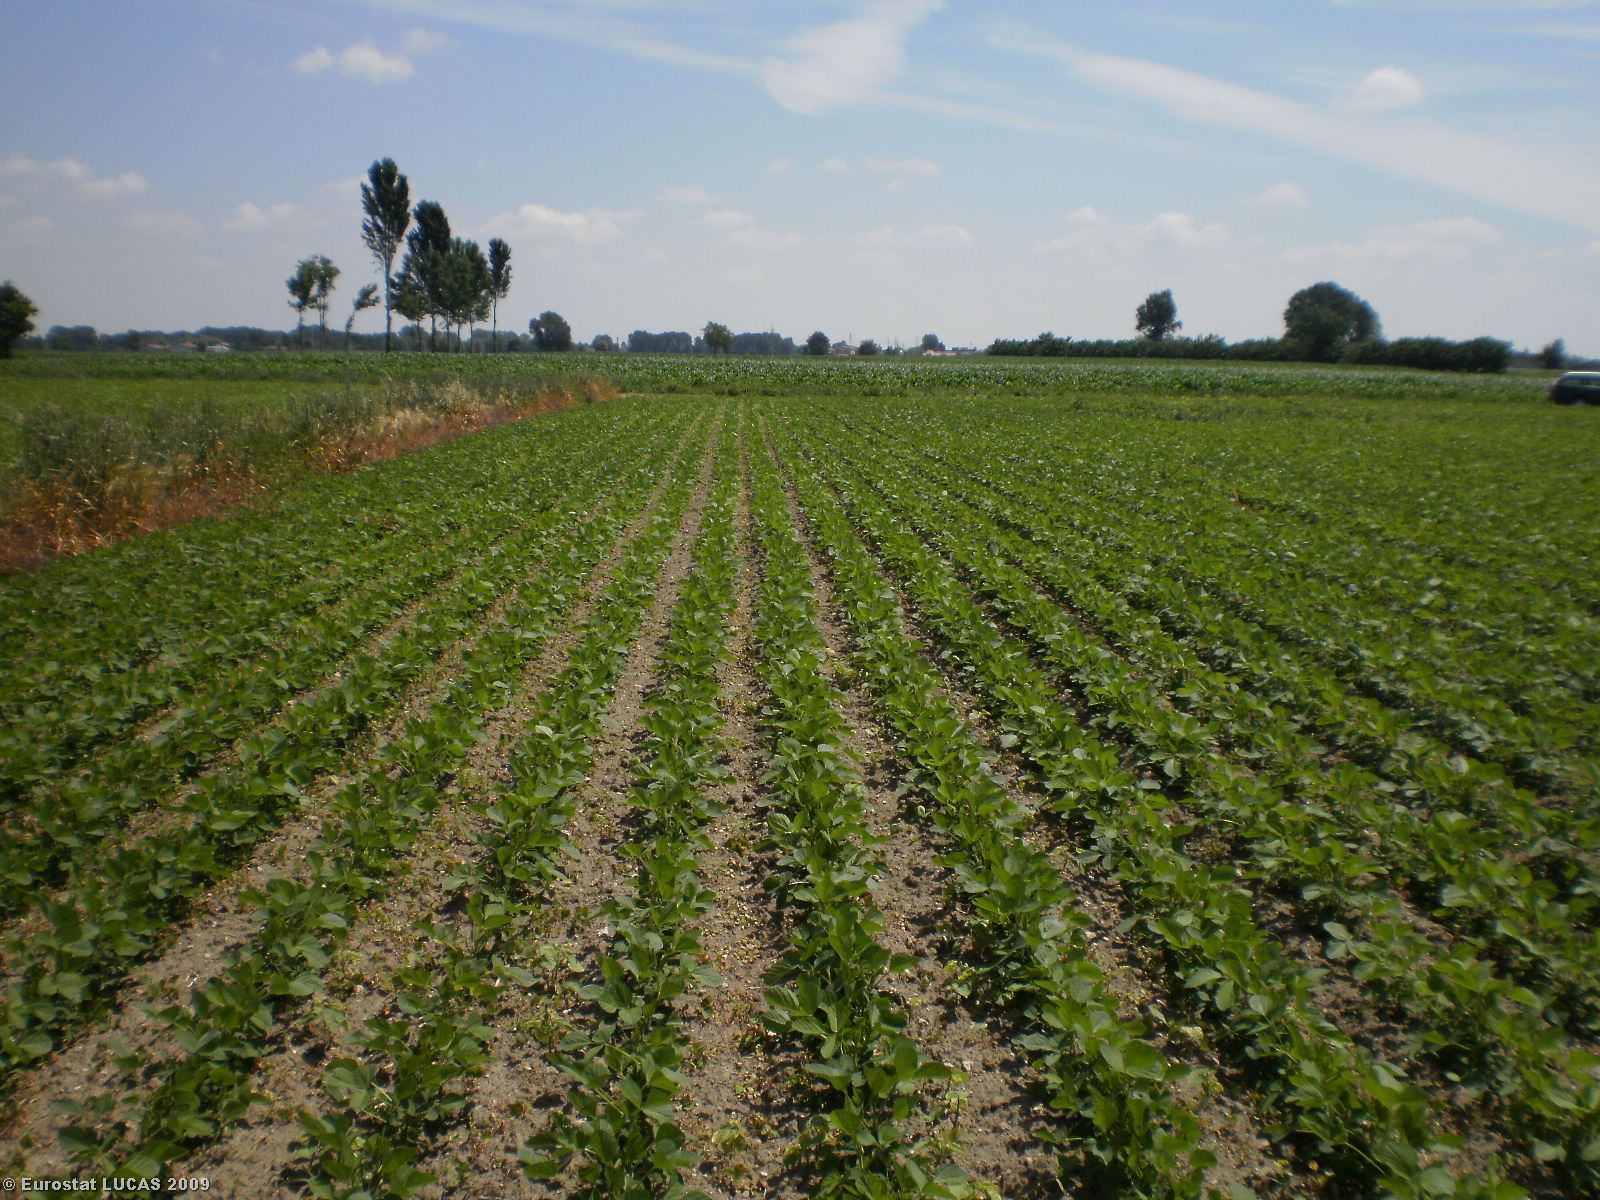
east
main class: Cropland
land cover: Soya
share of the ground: 50 - 75 %
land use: Agriculture (excluding fallow land and kitchen gardens)
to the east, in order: Soya; Tracks; Grass margins; Ditches and canals; Grass margins; Maize; Ditches and canals; Maize
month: May
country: IT
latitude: 45.2692
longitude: 10.4453
